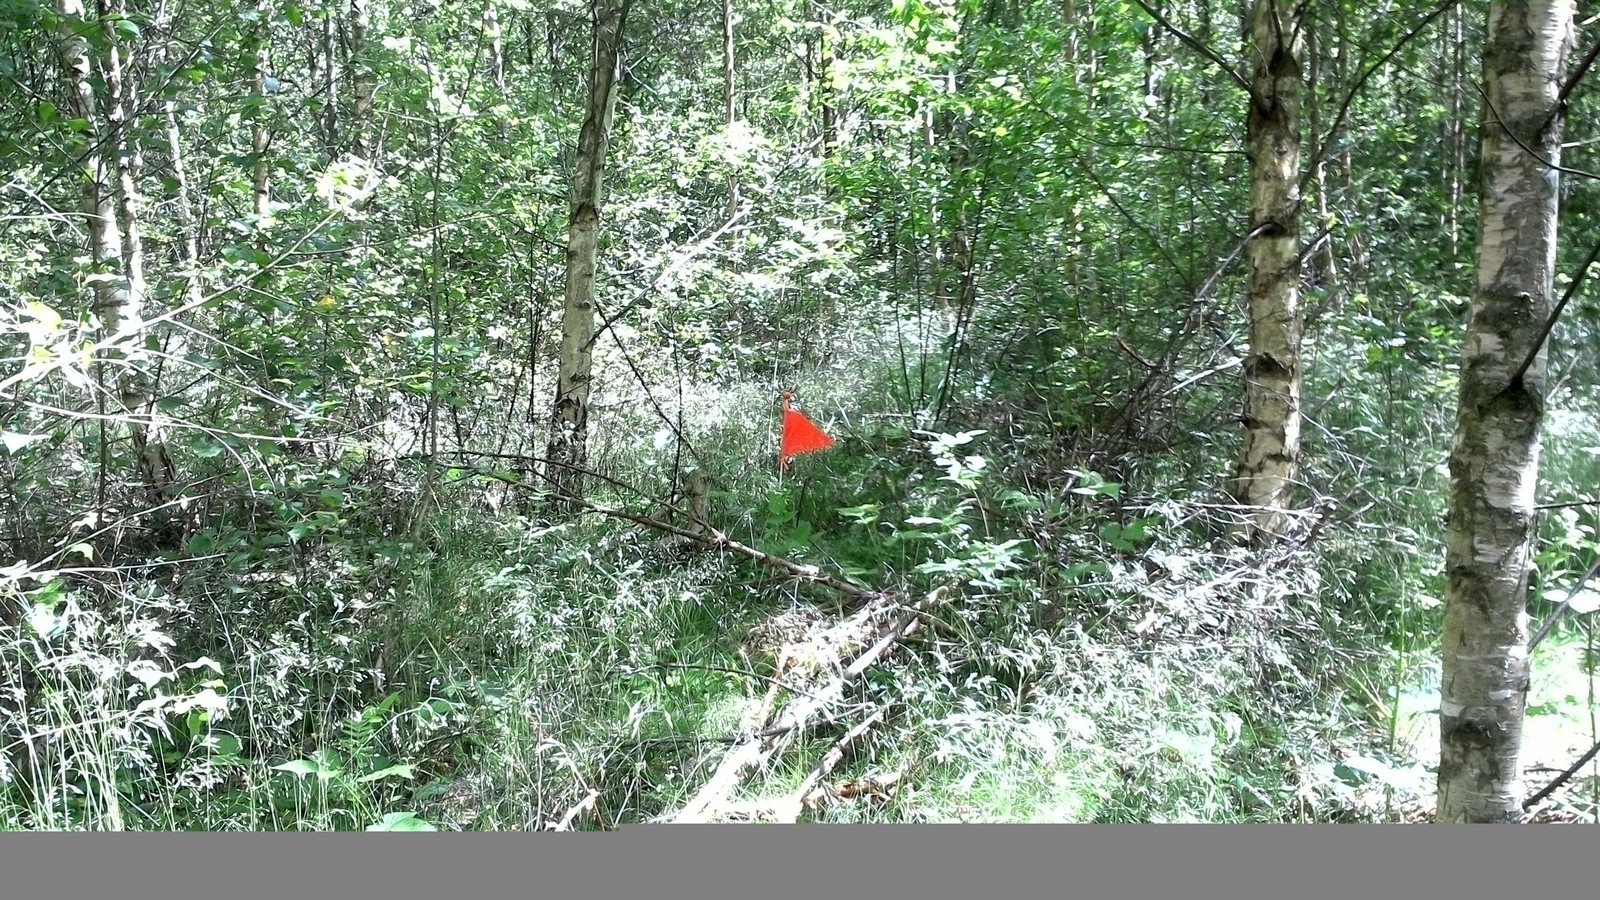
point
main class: Woodland
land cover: Broadleaved woodland
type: boreal forest
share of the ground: > 75 %
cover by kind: broadleaved forest trees 75 %, shrubs 10 %, herbaceous plants 10 %, coniferous forest trees 5 %
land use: Forestry
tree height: < 5 m
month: June
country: SE
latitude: 56.3329
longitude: 16.0661
